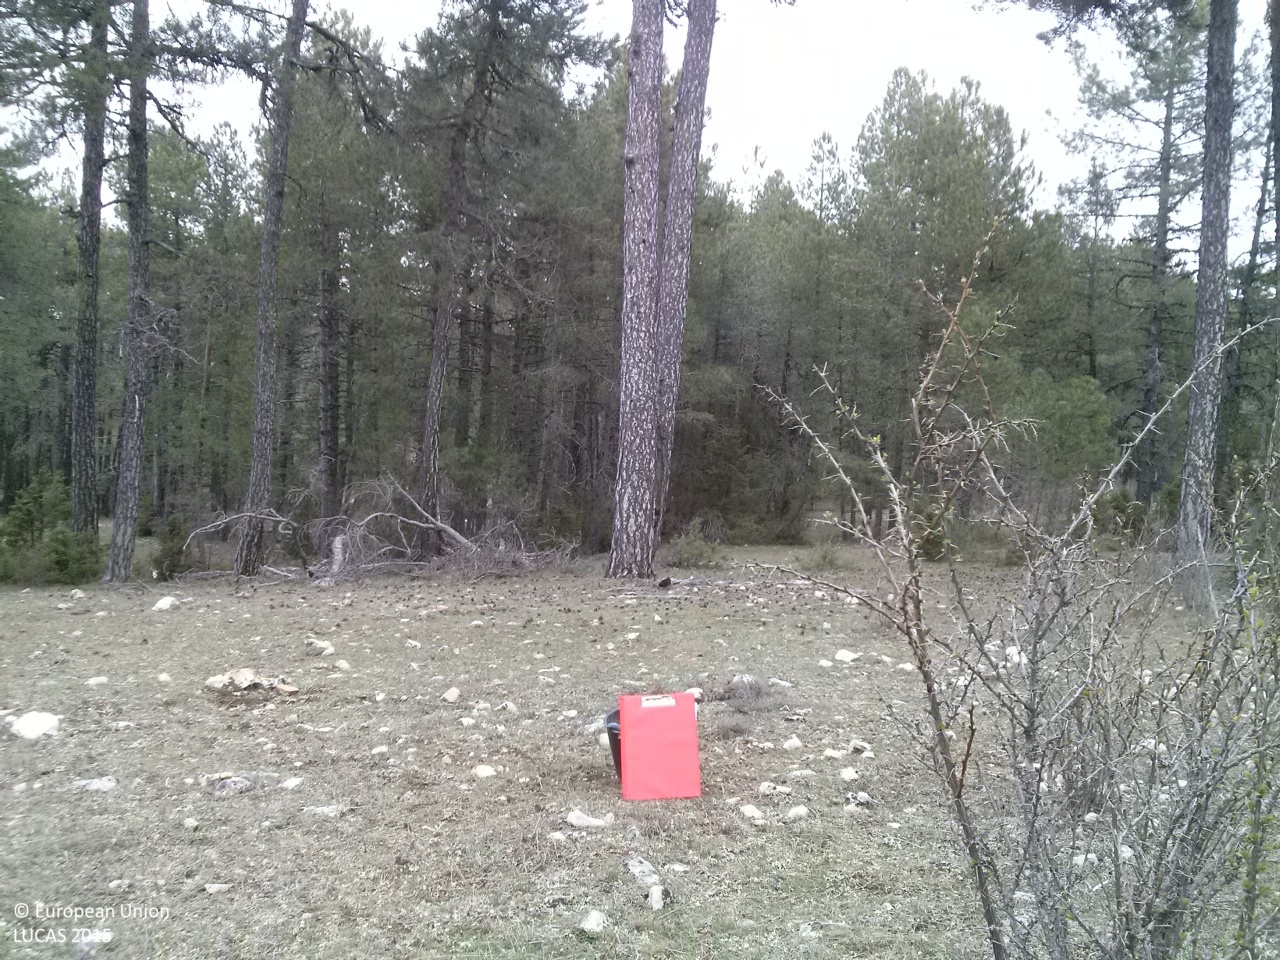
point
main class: Woodland
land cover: Pine dominated coniferous woodland
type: coniferous forest of the mediterranean region
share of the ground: 25 - 50 %
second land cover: Grassland without tree/shrub cover
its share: > 75 %
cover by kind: herbaceous plants 55 %, coniferous forest trees 40 %, shrubs 5 %
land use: Forestry
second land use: Agriculture (excluding fallow land and kitchen gardens)
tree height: > 5 m
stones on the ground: 10 - 25 %
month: April
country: ES
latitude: 40.2797
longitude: -1.9781
